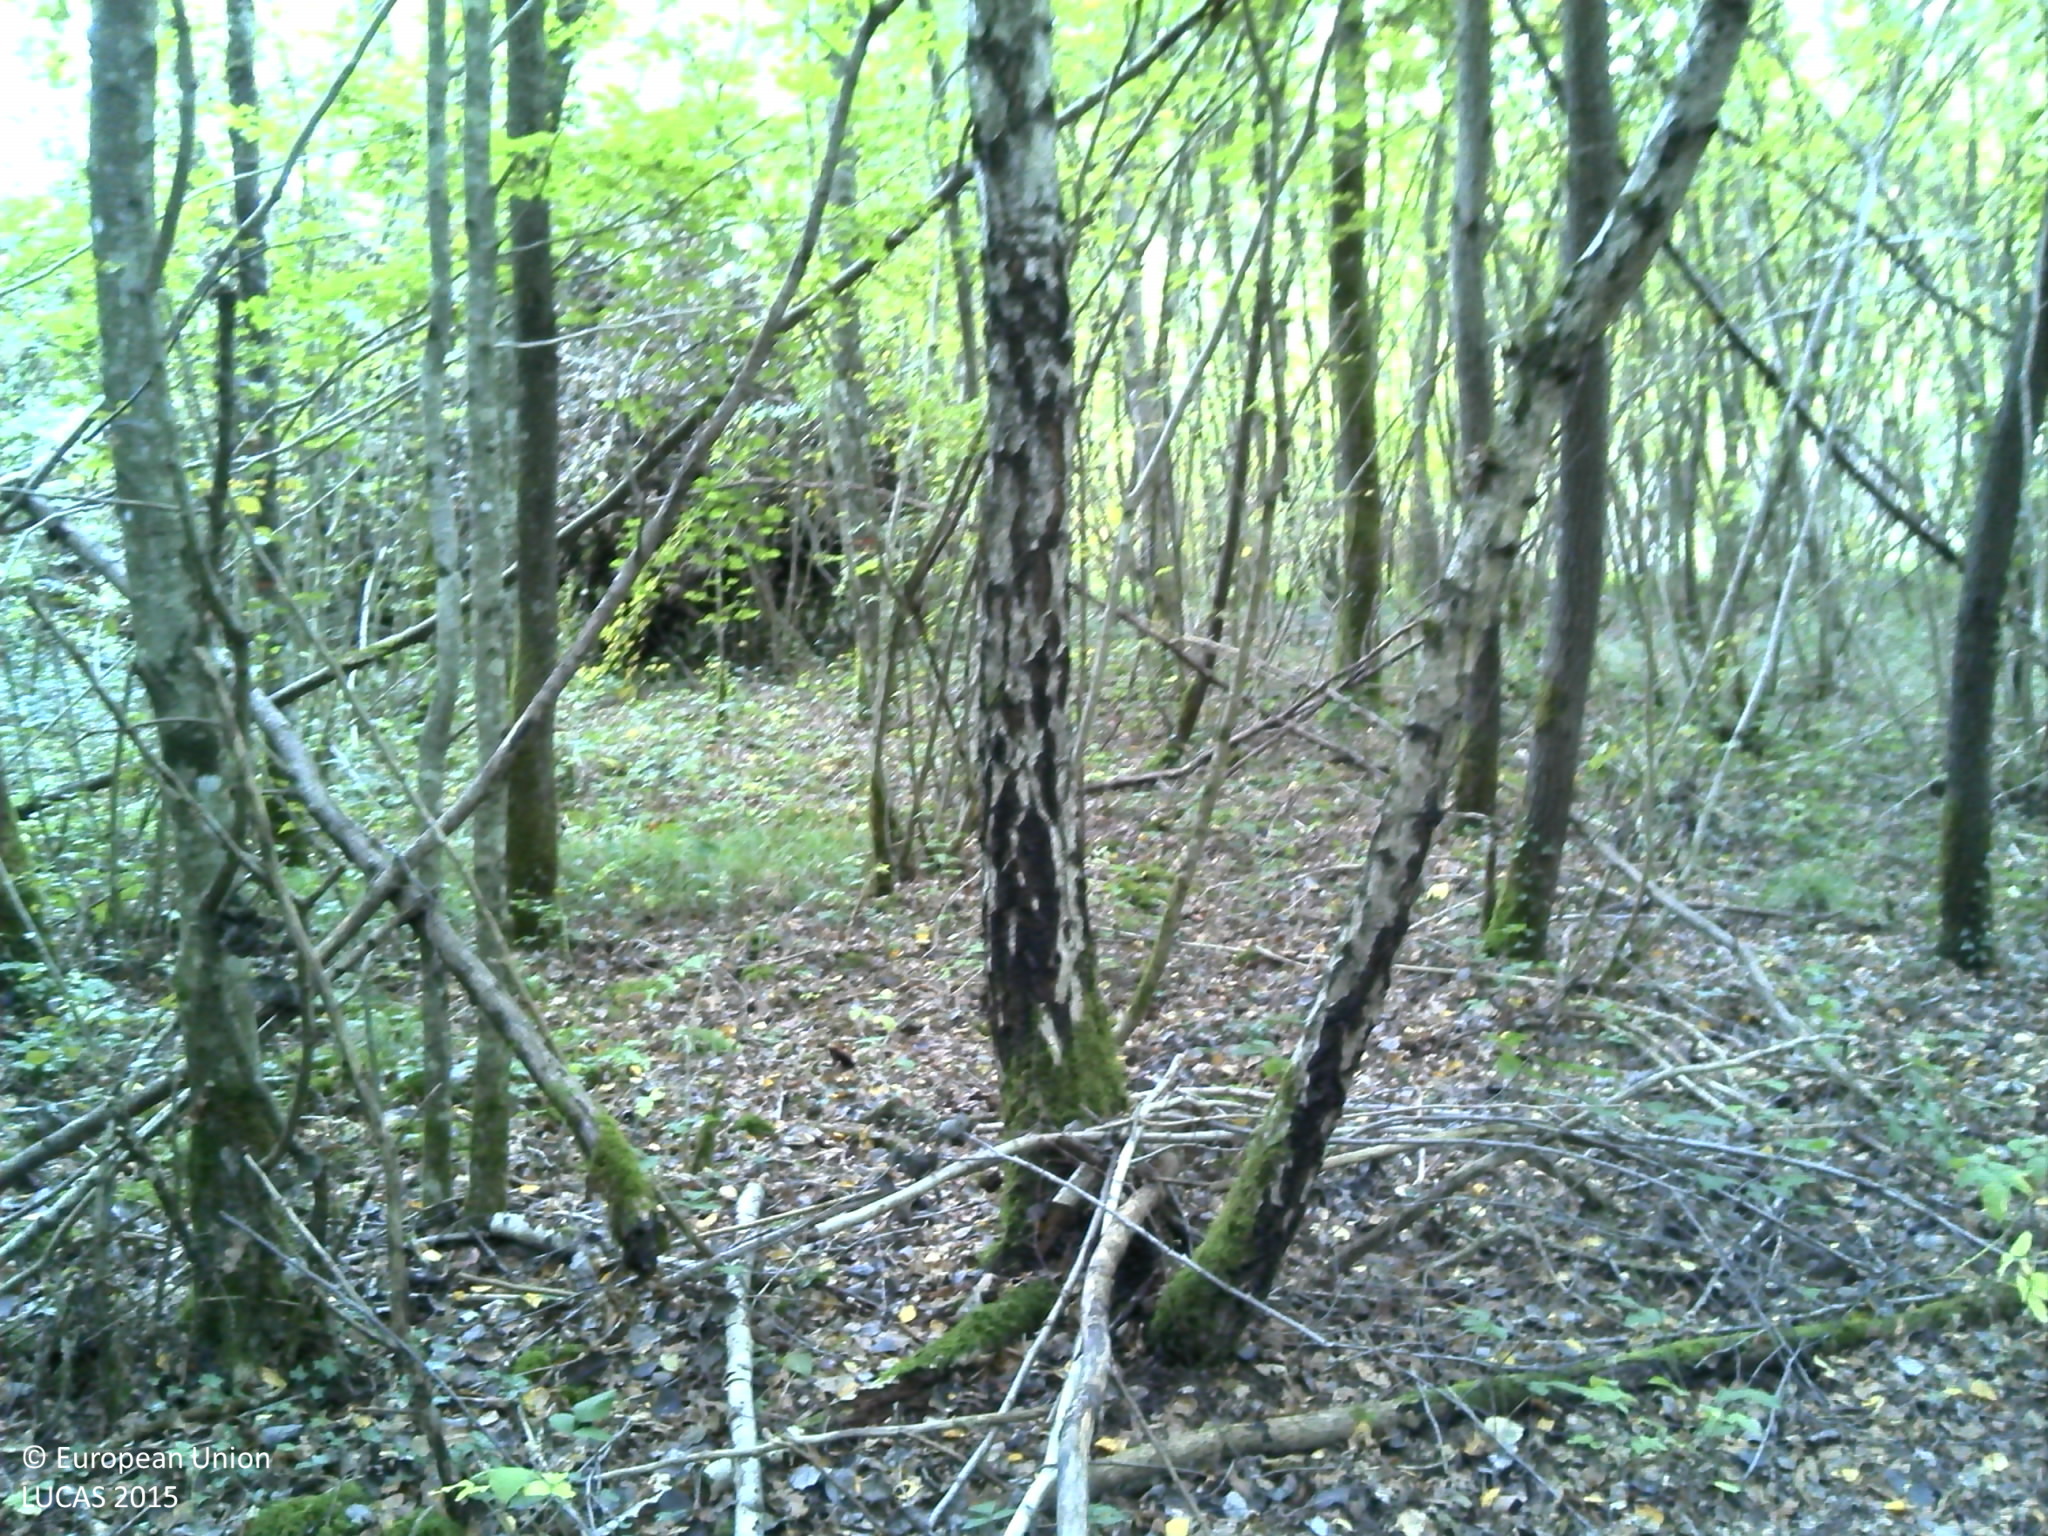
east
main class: Woodland
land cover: Broadleaved woodland
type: non-riverine alder, birch or aspen forest
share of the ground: > 75 %
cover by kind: broadleaved forest trees 85 %, herbaceous plants 10 %
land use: Forestry
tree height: > 5 m
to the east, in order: Broadleaved woodland; Tracks; Broadleaved woodland; Tracks; Broadleaved woodland
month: October
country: FR
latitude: 46.8945
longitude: 4.8428
